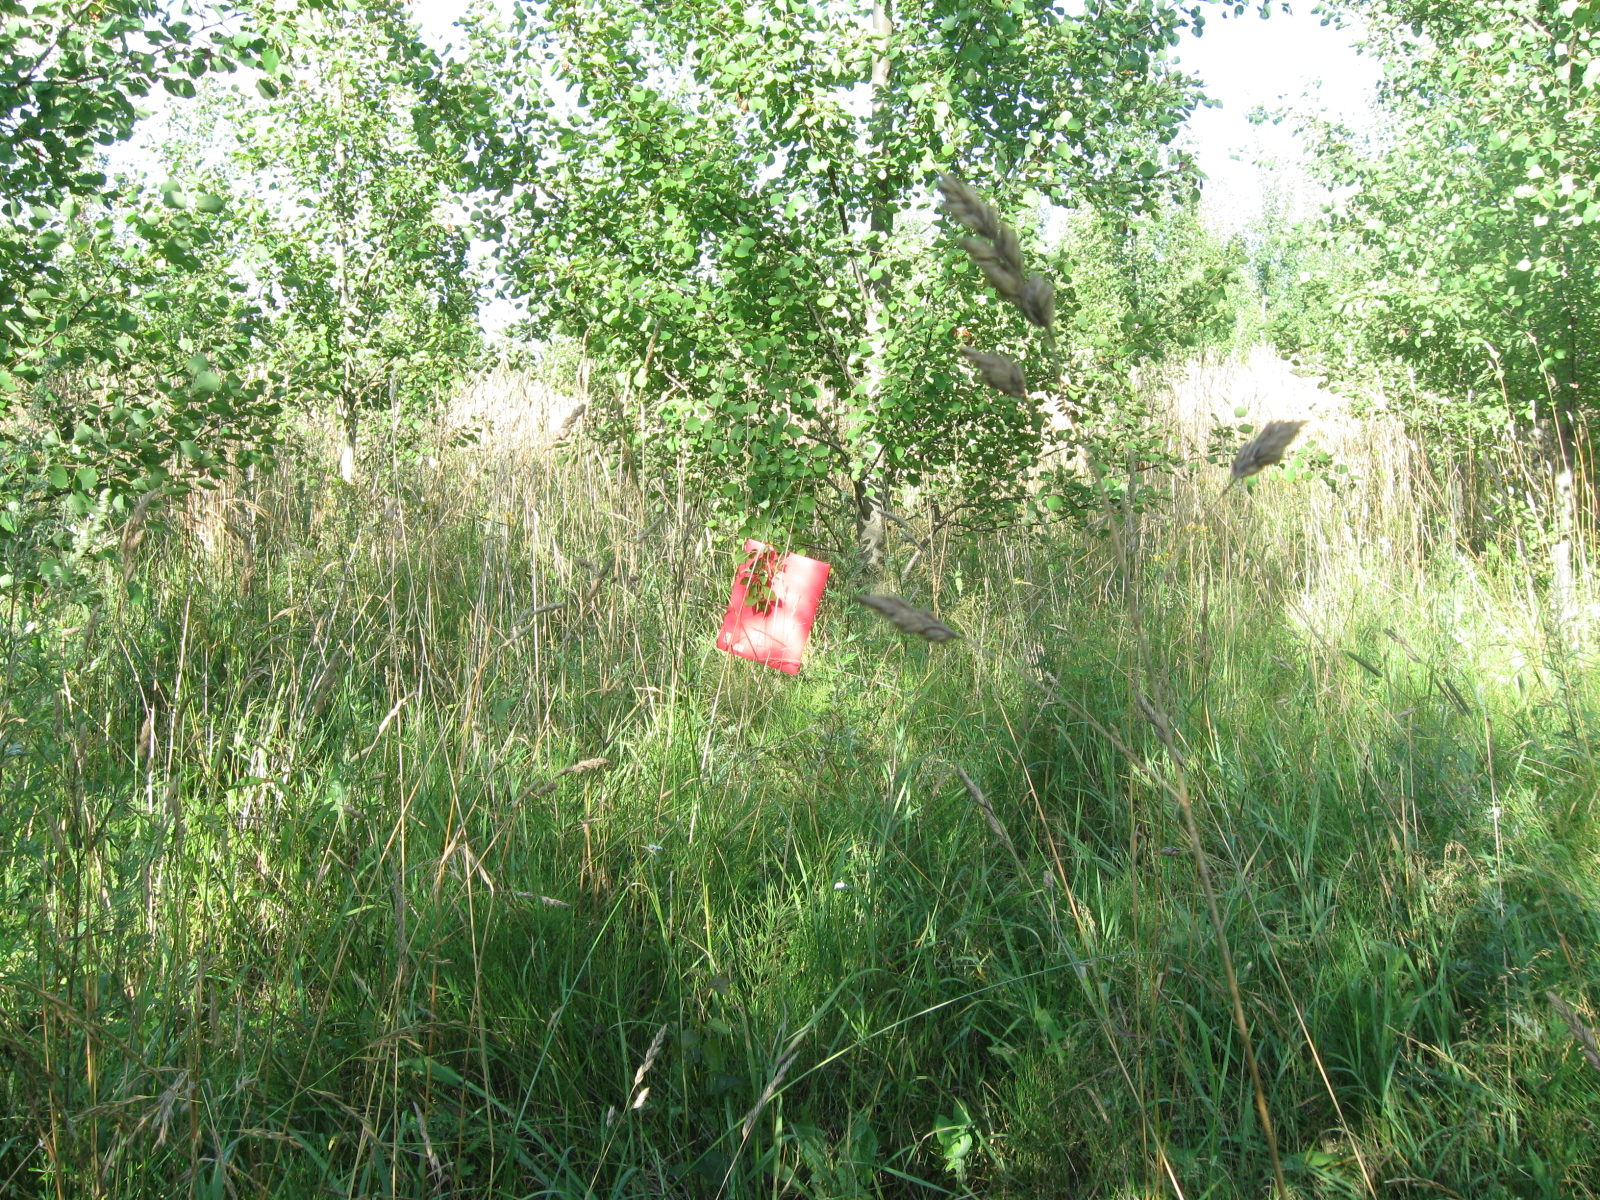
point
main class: Woodland
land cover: Broadleaved woodland
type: non-riverine alder, birch or aspen forest
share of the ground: 50 - 75 %
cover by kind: broadleaved forest trees 55 %, herbaceous plants 45 %
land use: Forestry
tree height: < 5 m
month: July
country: LT
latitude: 54.3053
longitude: 23.4675
